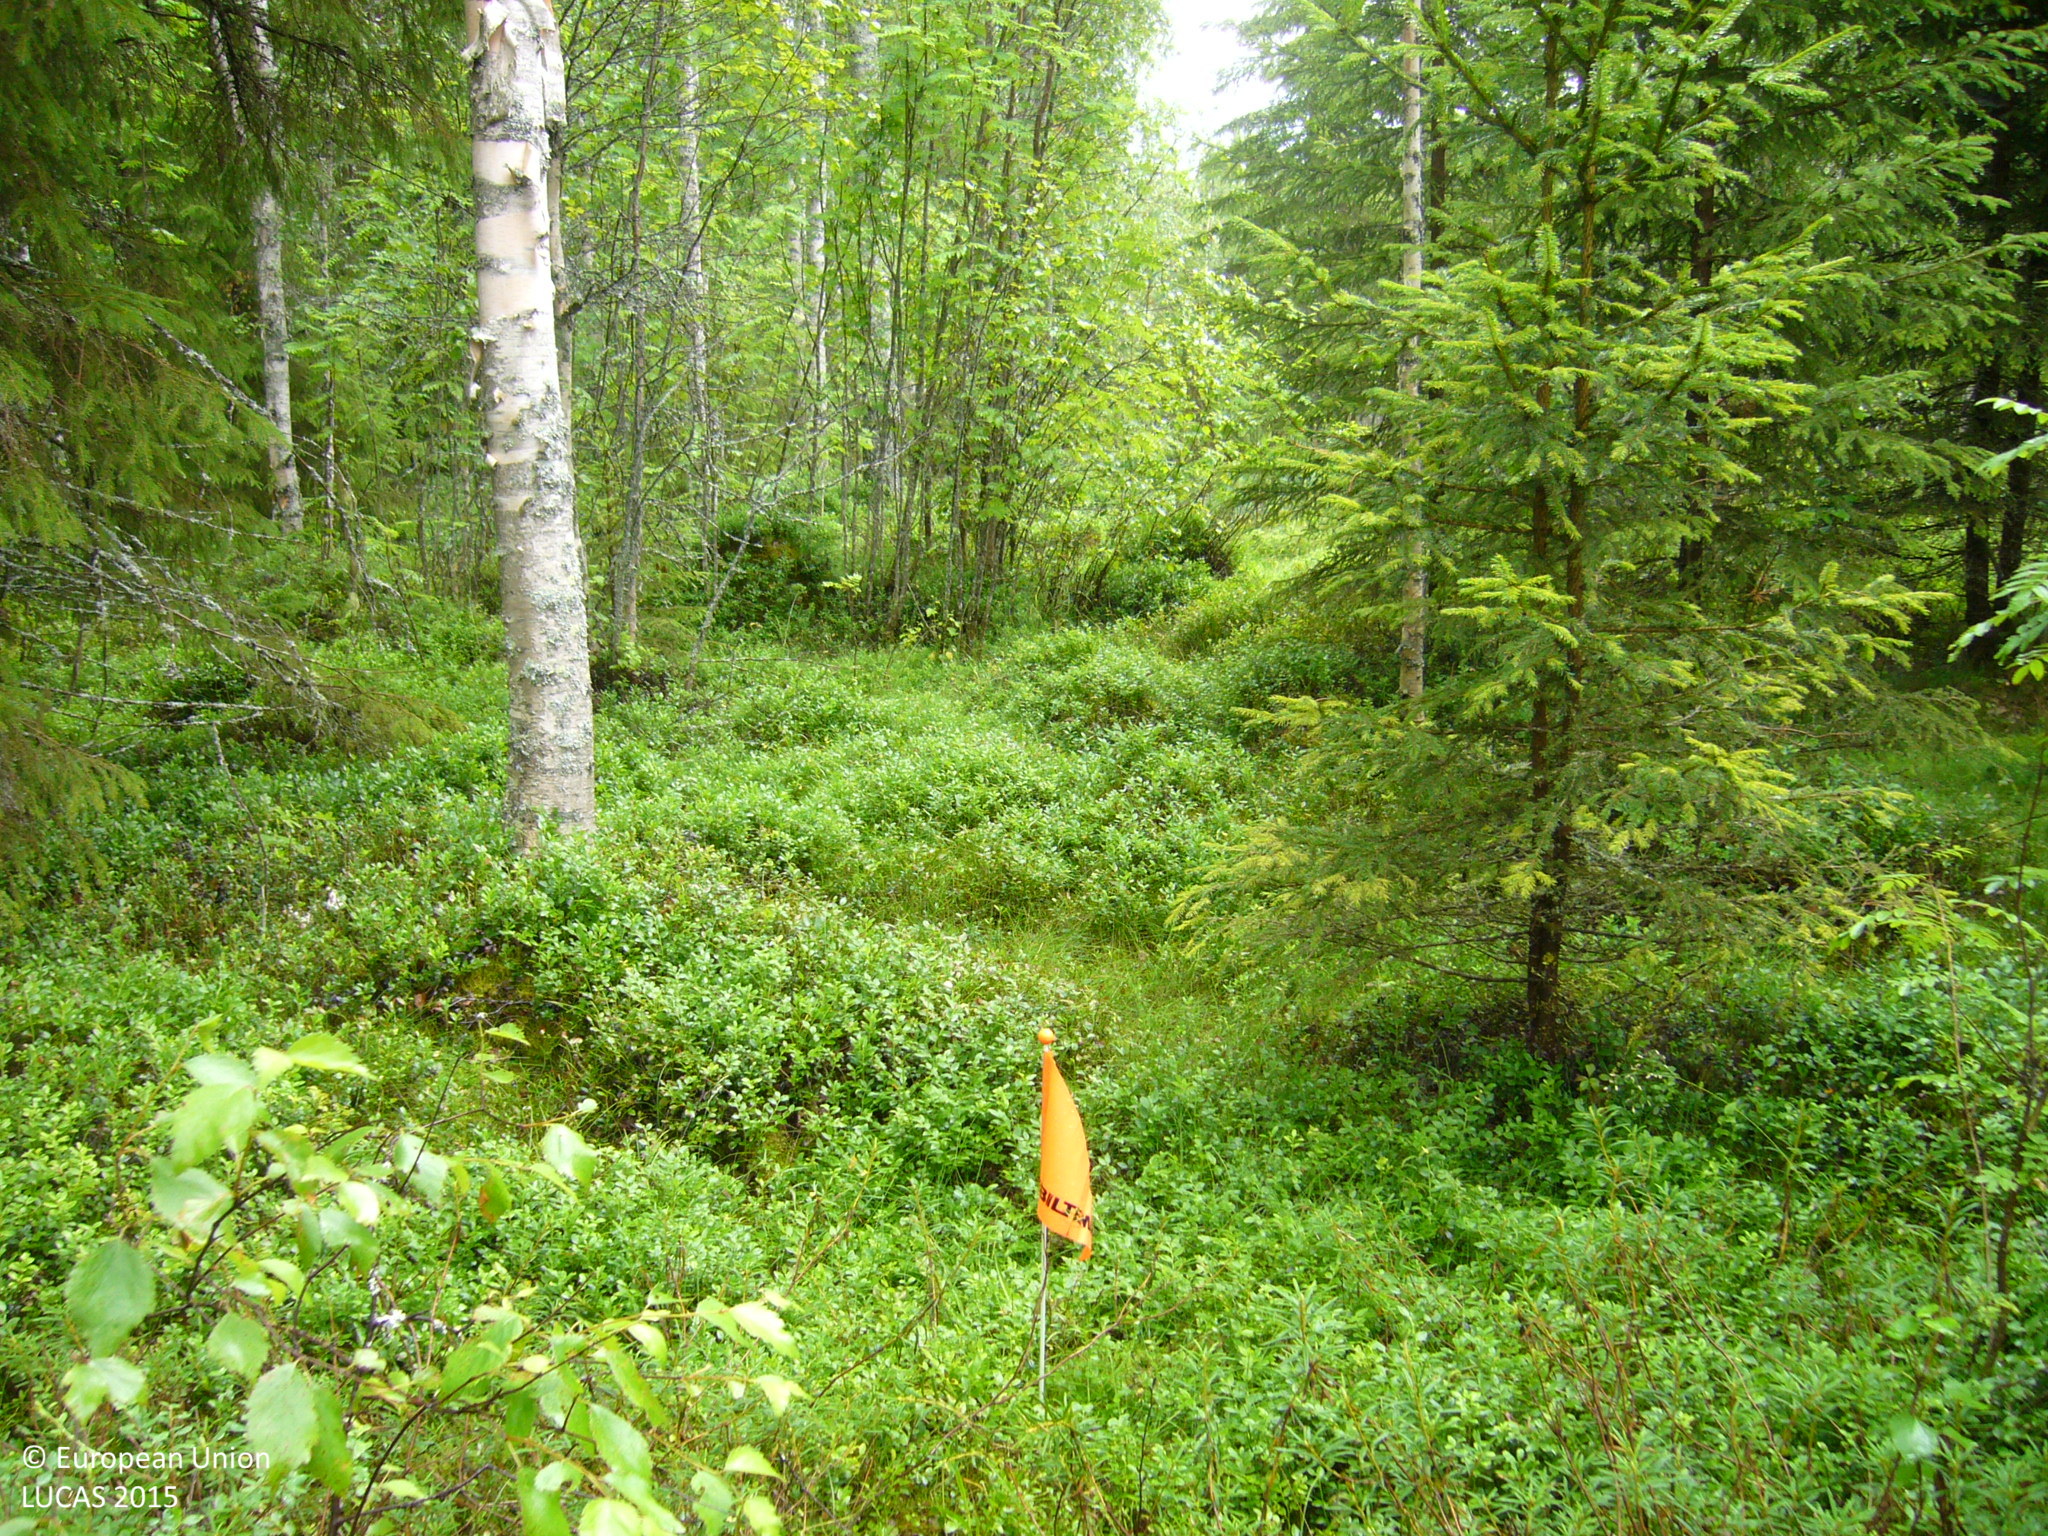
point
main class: Woodland
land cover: Other mixed woodland
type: boreal forest
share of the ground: > 75 %
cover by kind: broadleaved forest trees 45 %, coniferous forest trees 35 %, shrubs 20 %
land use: Forestry
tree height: > 5 m
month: July
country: FI
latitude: 63.8214
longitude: 25.9763
